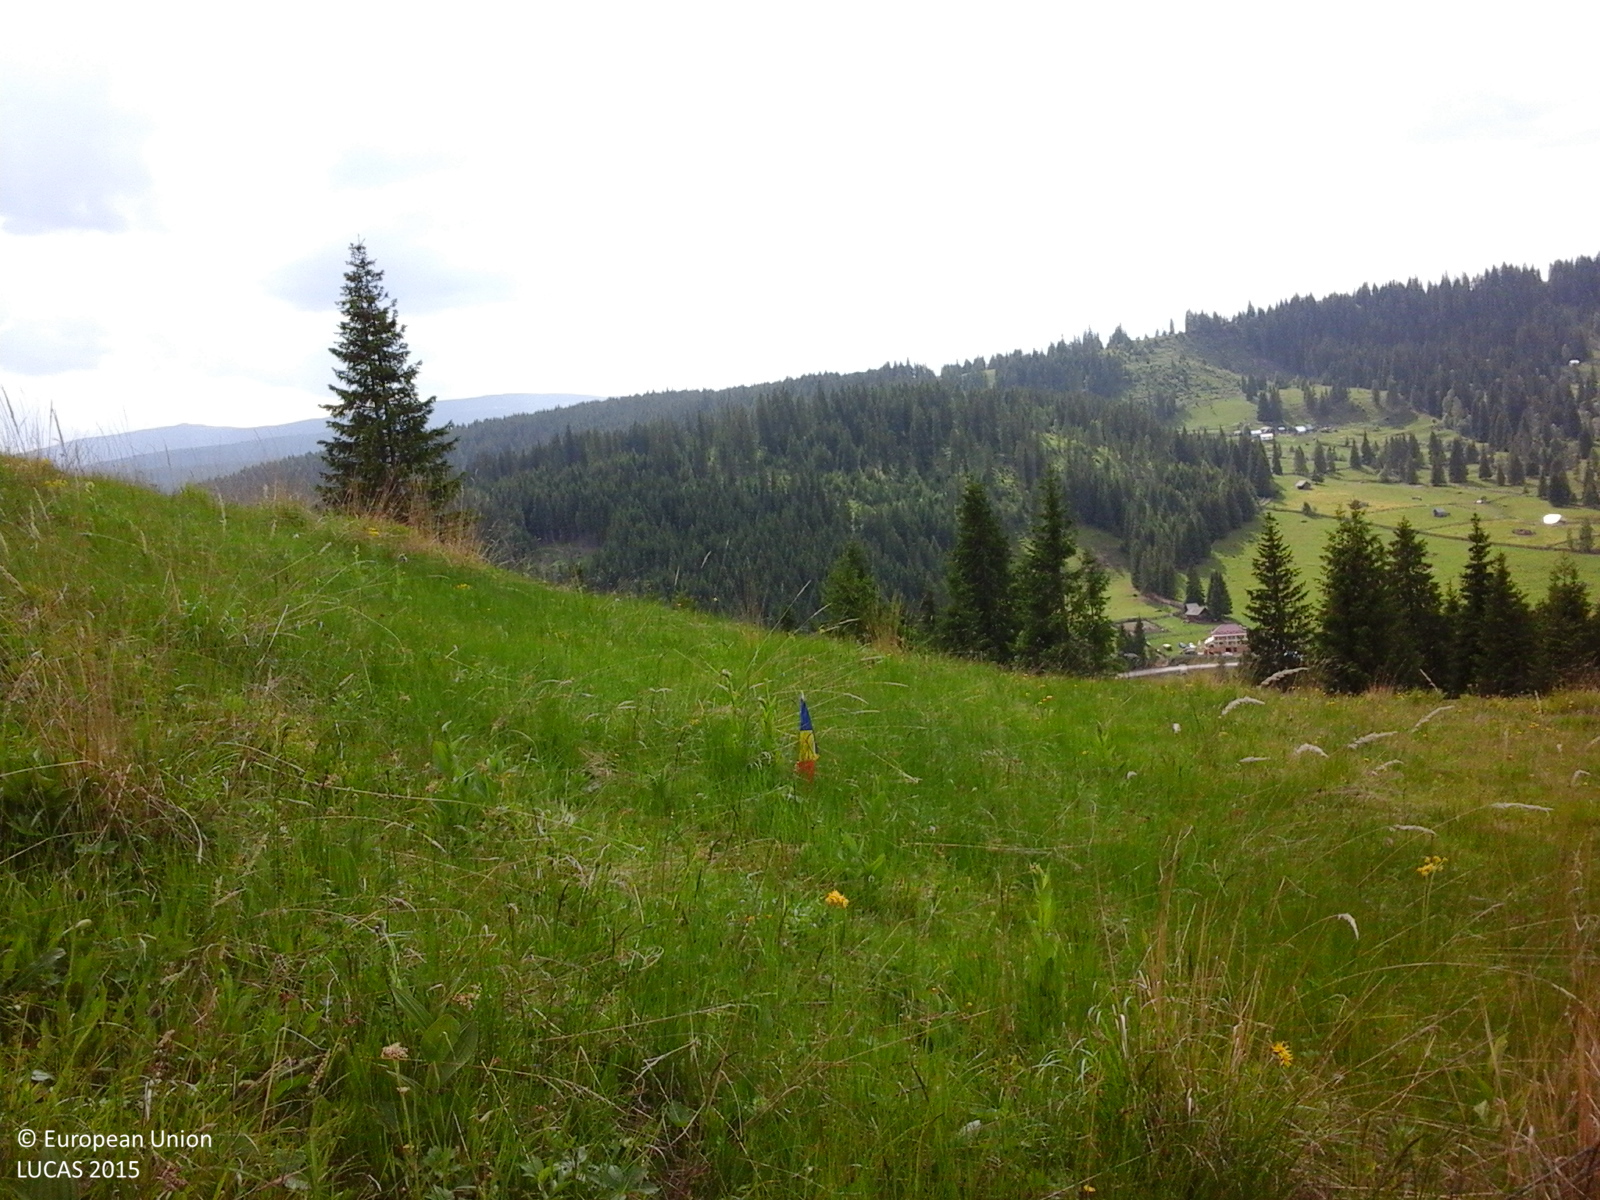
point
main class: Grassland
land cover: Grassland without tree/shrub cover
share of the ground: > 75 %
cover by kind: herbaceous plants 100 %
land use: Agriculture (excluding fallow land and kitchen gardens)
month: June
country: RO
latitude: 47.1831
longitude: 25.4331
